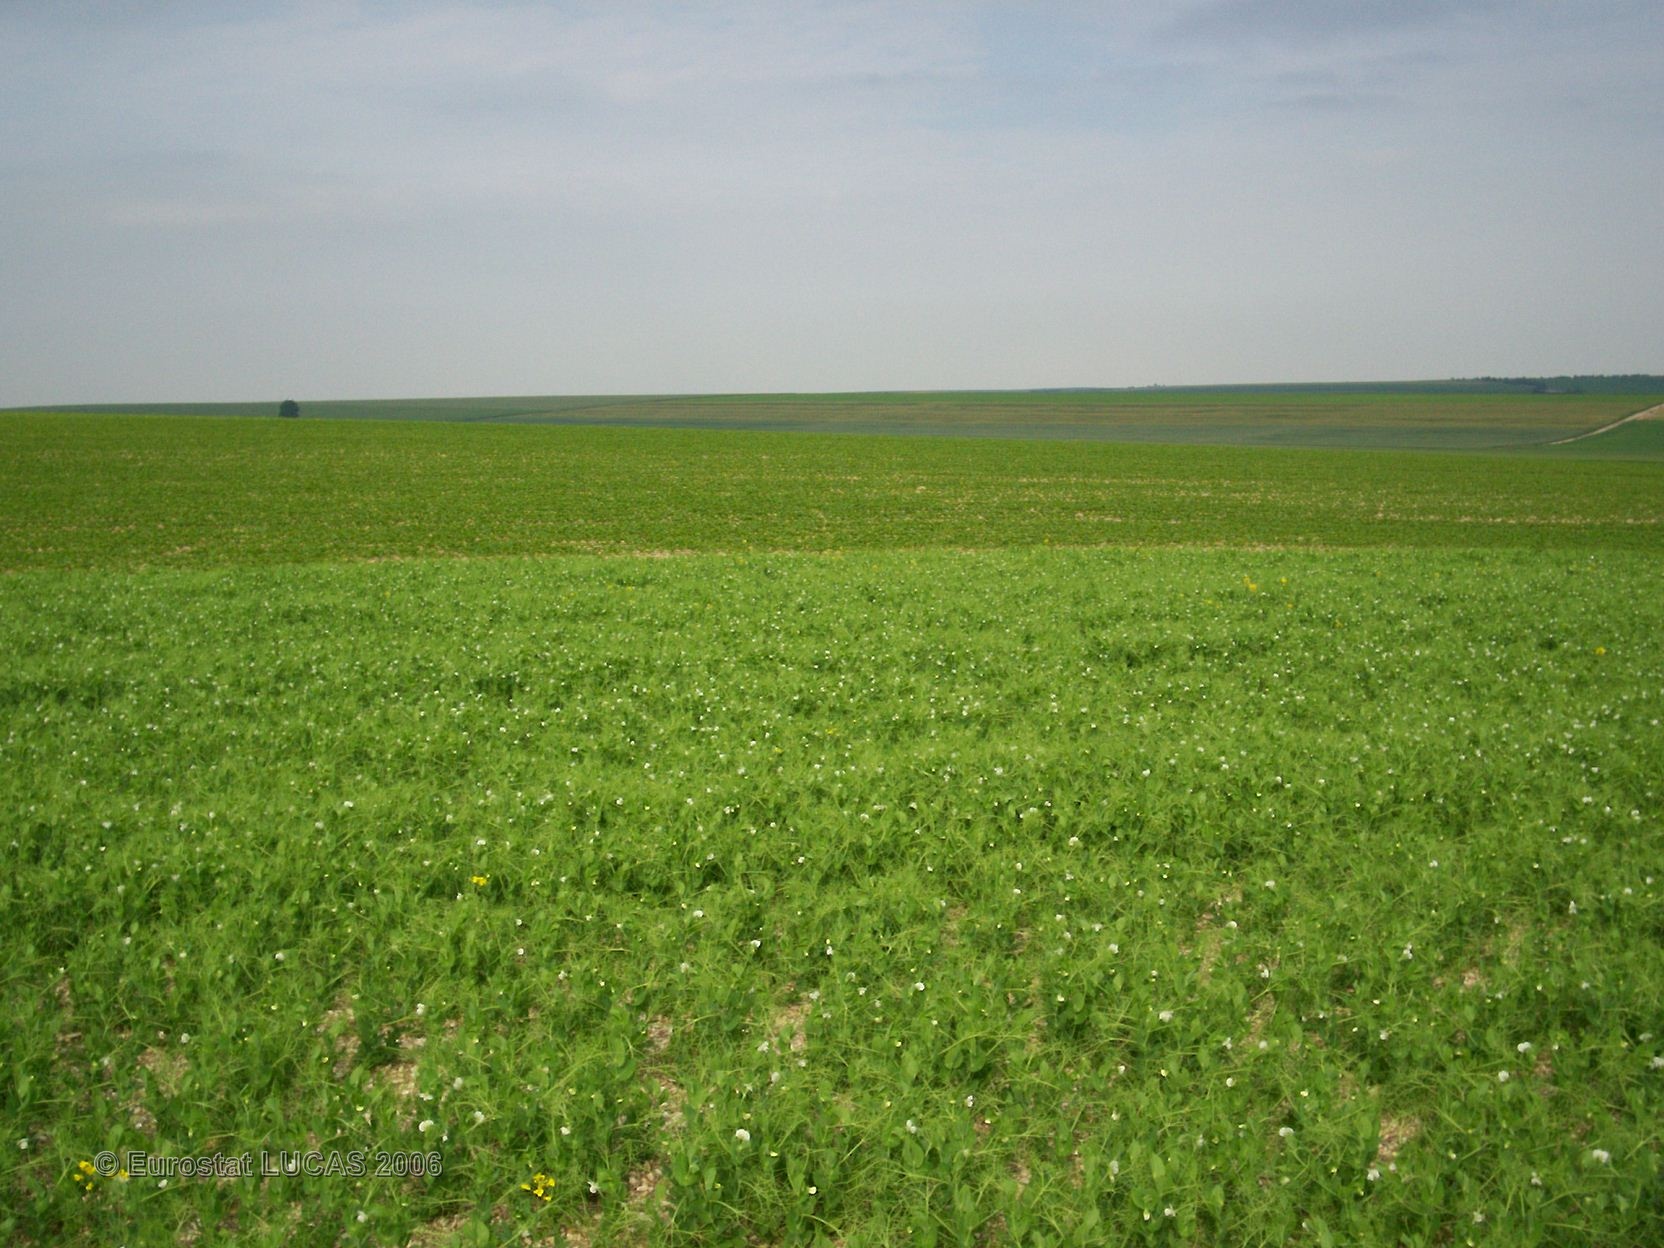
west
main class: Cropland
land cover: Dry pulses
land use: Agriculture (excluding fallow land and kitchen gardens)
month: June
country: FR
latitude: 48.7350
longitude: 4.4902
